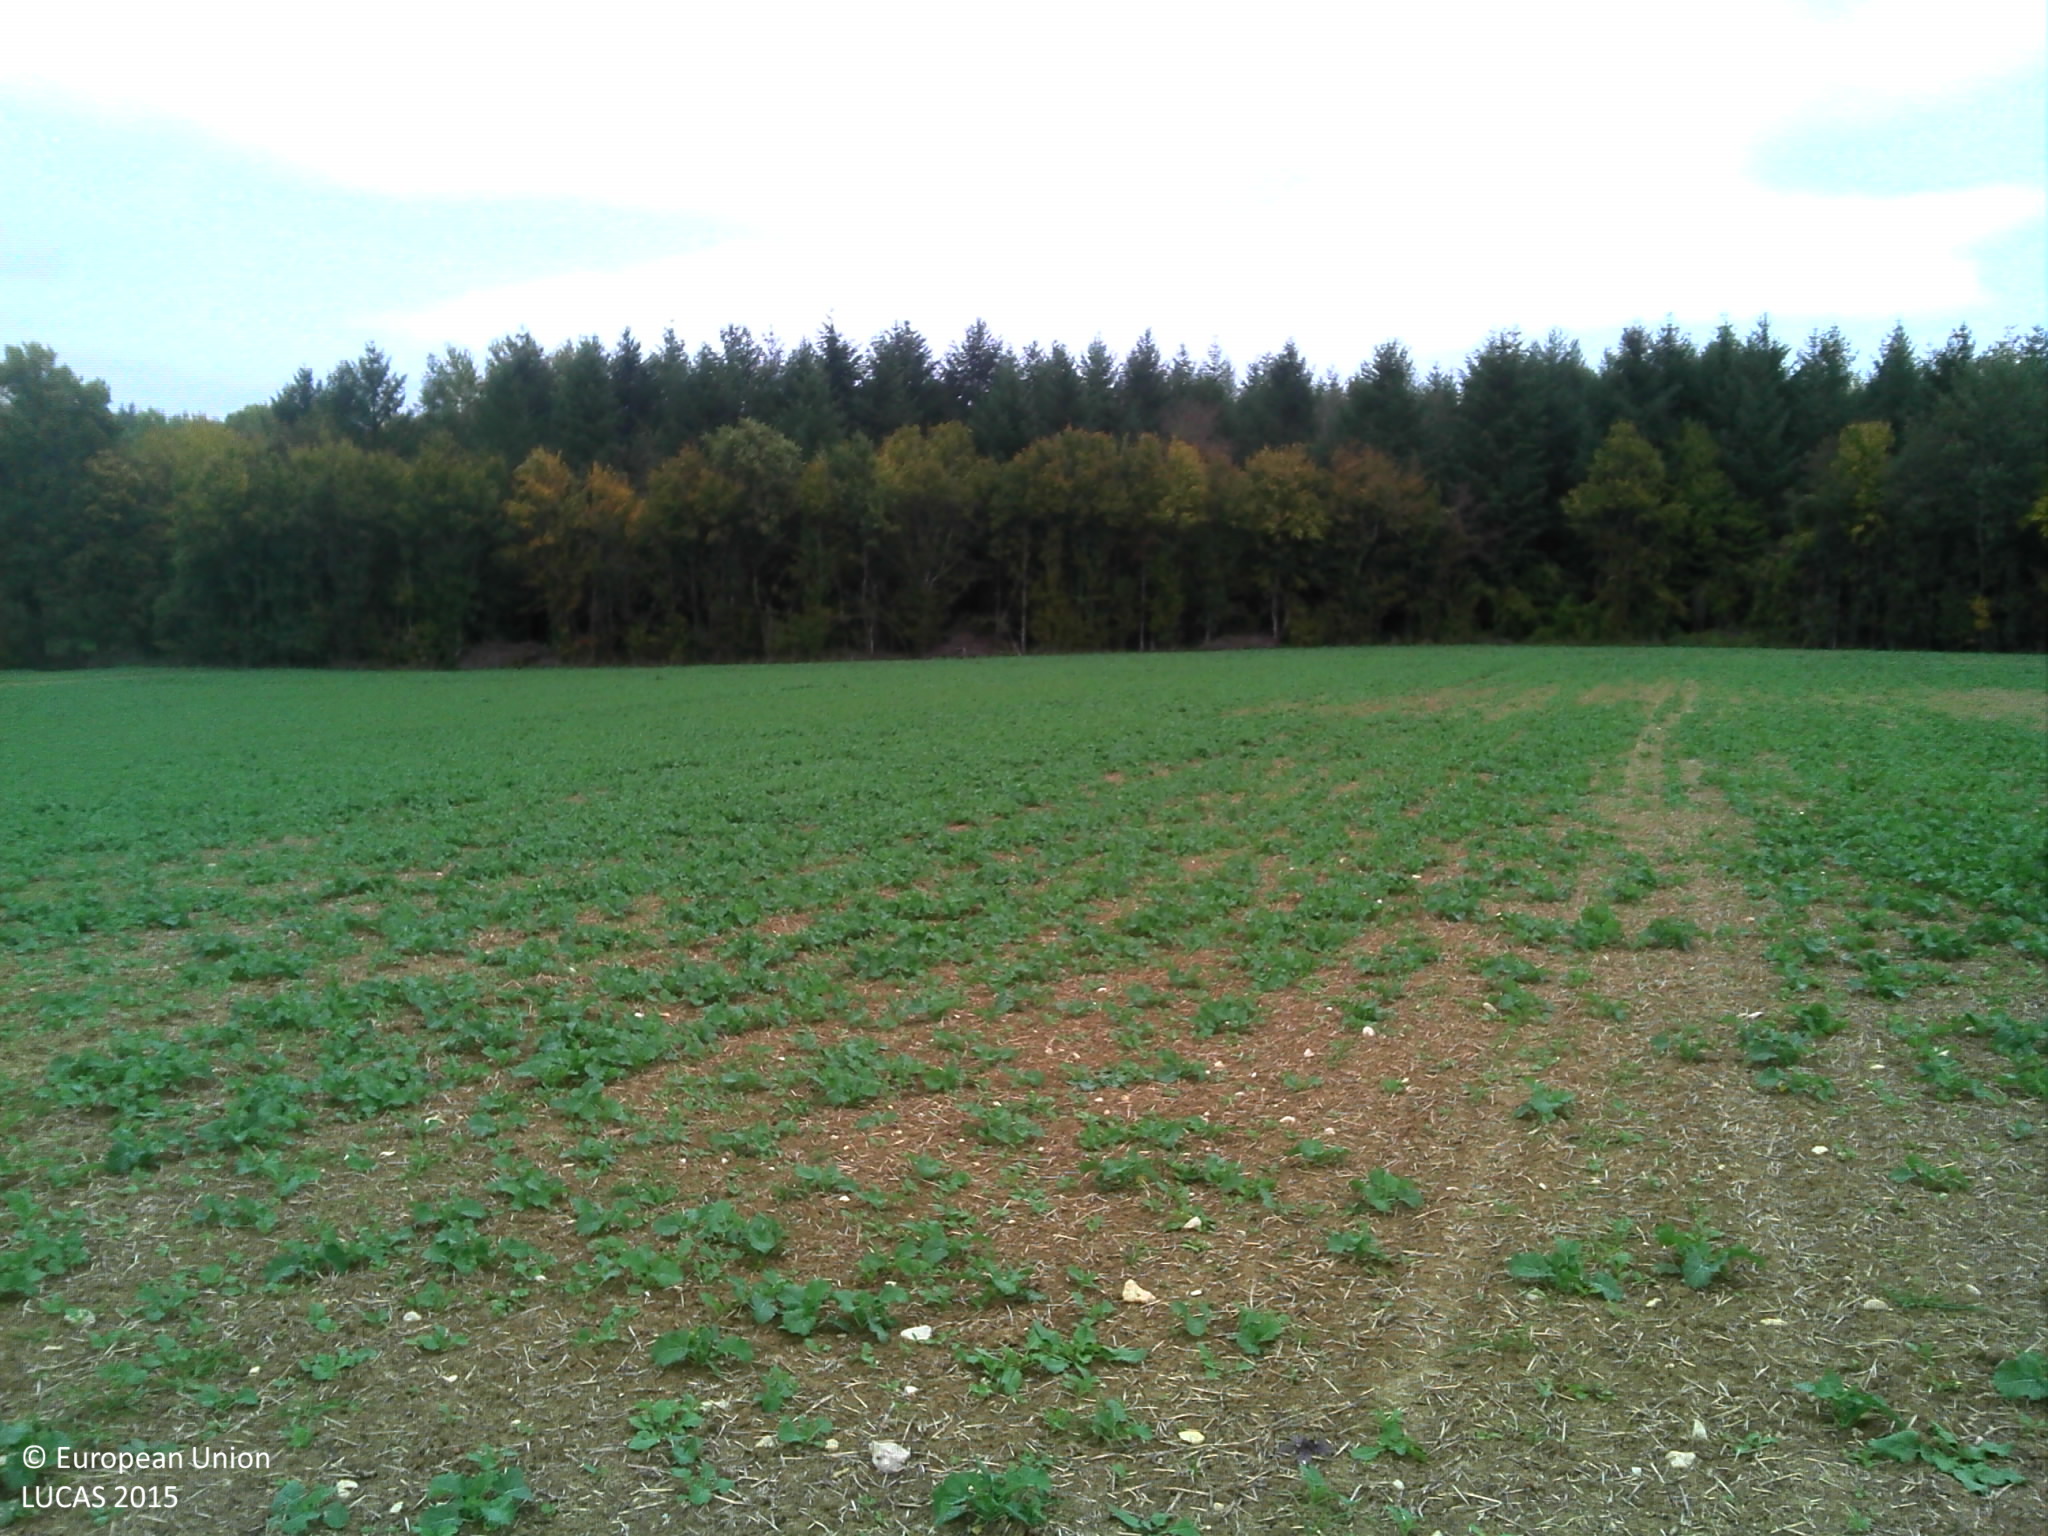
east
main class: Cropland
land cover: Rape and turnip rape
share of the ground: 10 - 25 %
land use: Agriculture (excluding fallow land and kitchen gardens)
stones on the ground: < 10 %
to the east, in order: Rape and turnip rape; Ditches and canals; Pine dominated coniferous woodland; Grass margins; Pine dominated coniferous woodland; Grass margins; Pine dominated coniferous woodland; Grass margins; Pine dominated coniferous woodland; Grass margins; Pine dominated coniferous woodland
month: October
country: FR
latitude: 47.3898
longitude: 5.4305
